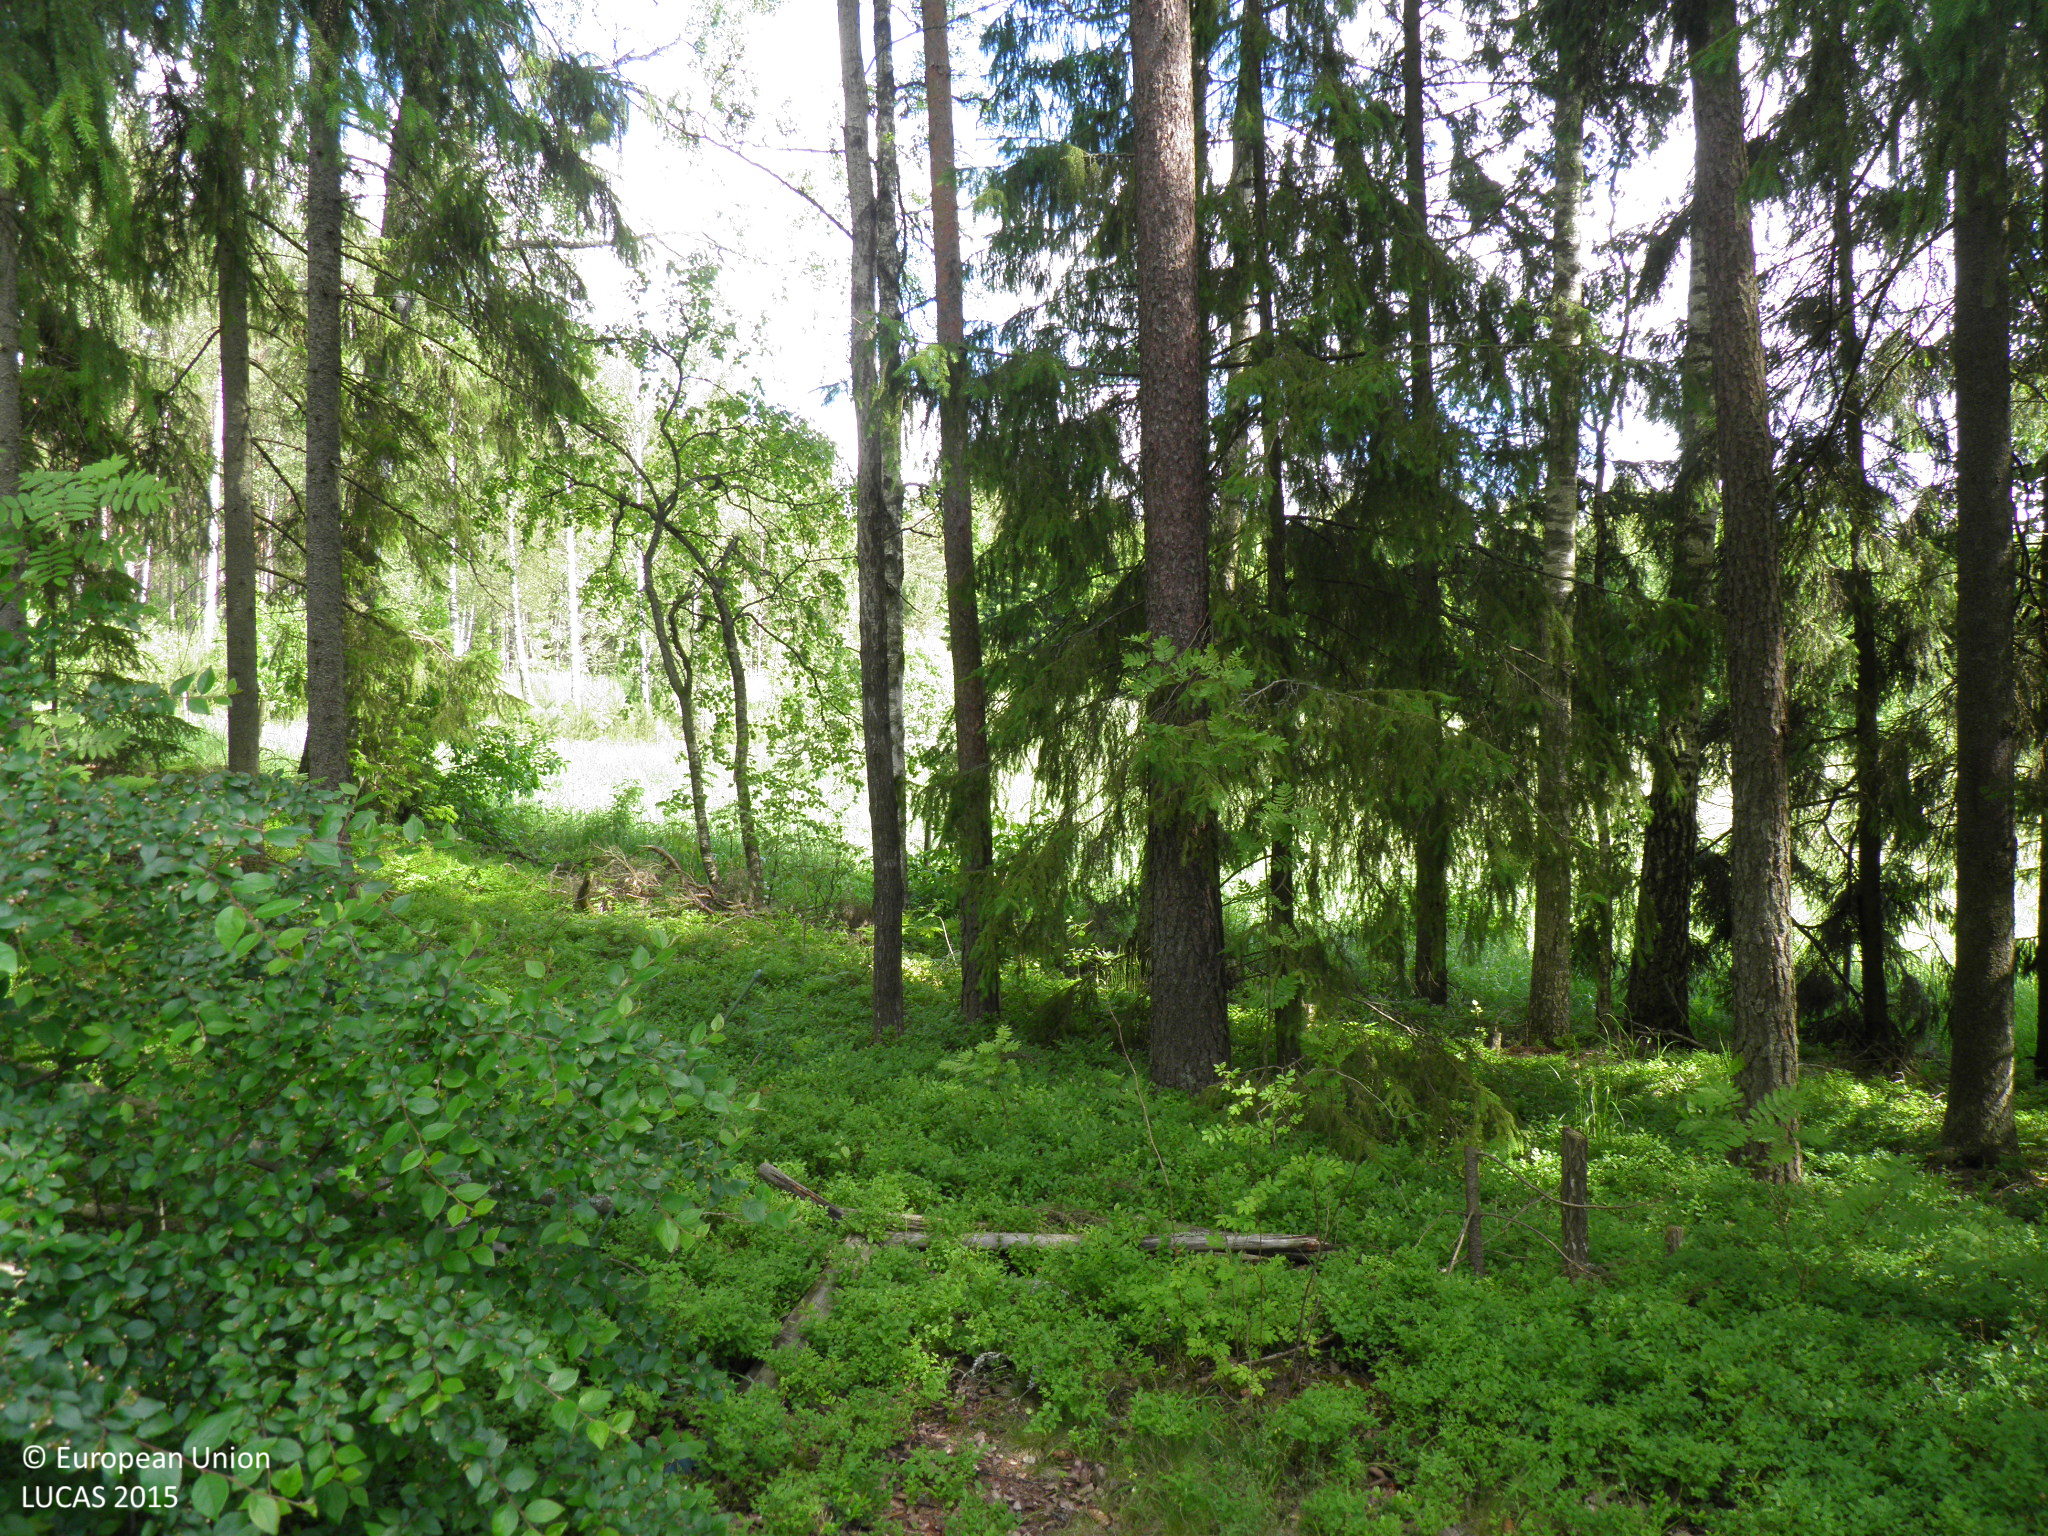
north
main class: Grassland
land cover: Grassland without tree/shrub cover
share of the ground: > 75 %
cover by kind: herbaceous plants 95 %, shrubs 5 %
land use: Residential
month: June
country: FI
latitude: 60.3233
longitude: 22.6214
